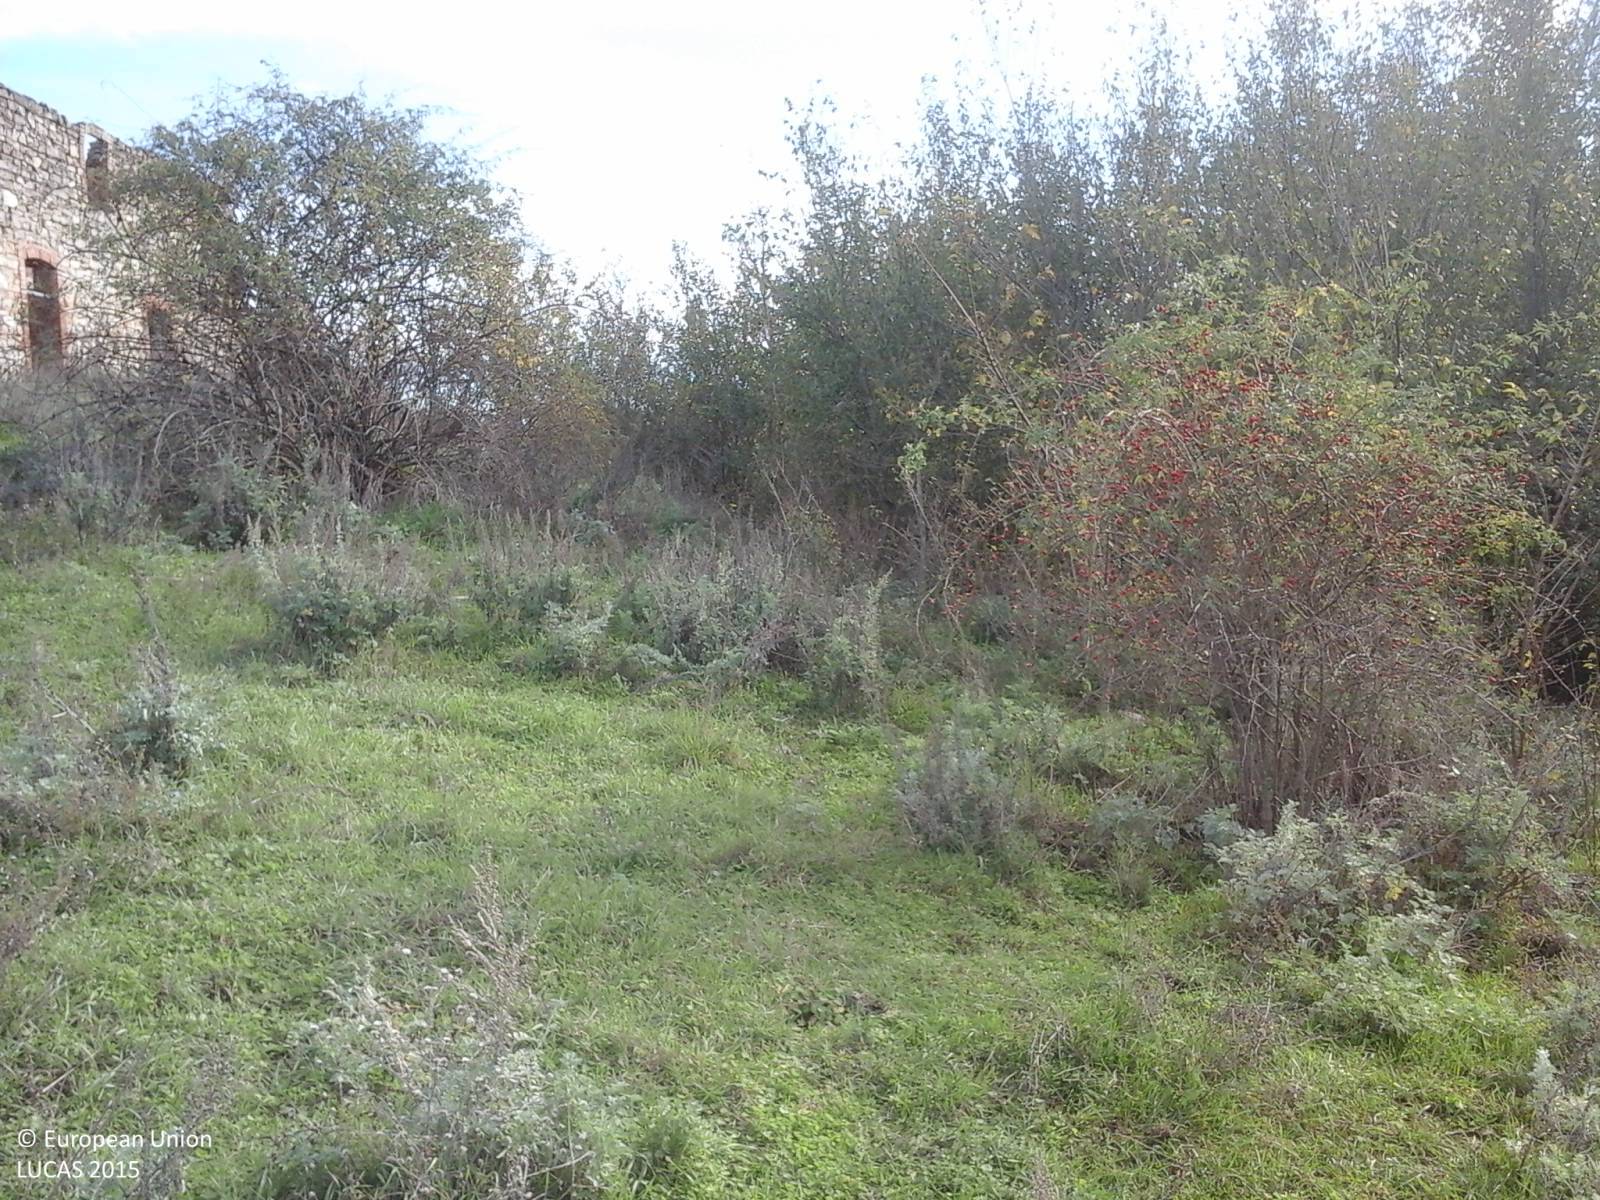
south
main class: Woodland
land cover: Broadleaved woodland
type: thermophilous deciduous forest
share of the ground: > 75 %
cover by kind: broadleaved forest trees 100 %
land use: Forestry
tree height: > 5 m
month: October
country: IT
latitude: 42.8276
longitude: 12.2560
